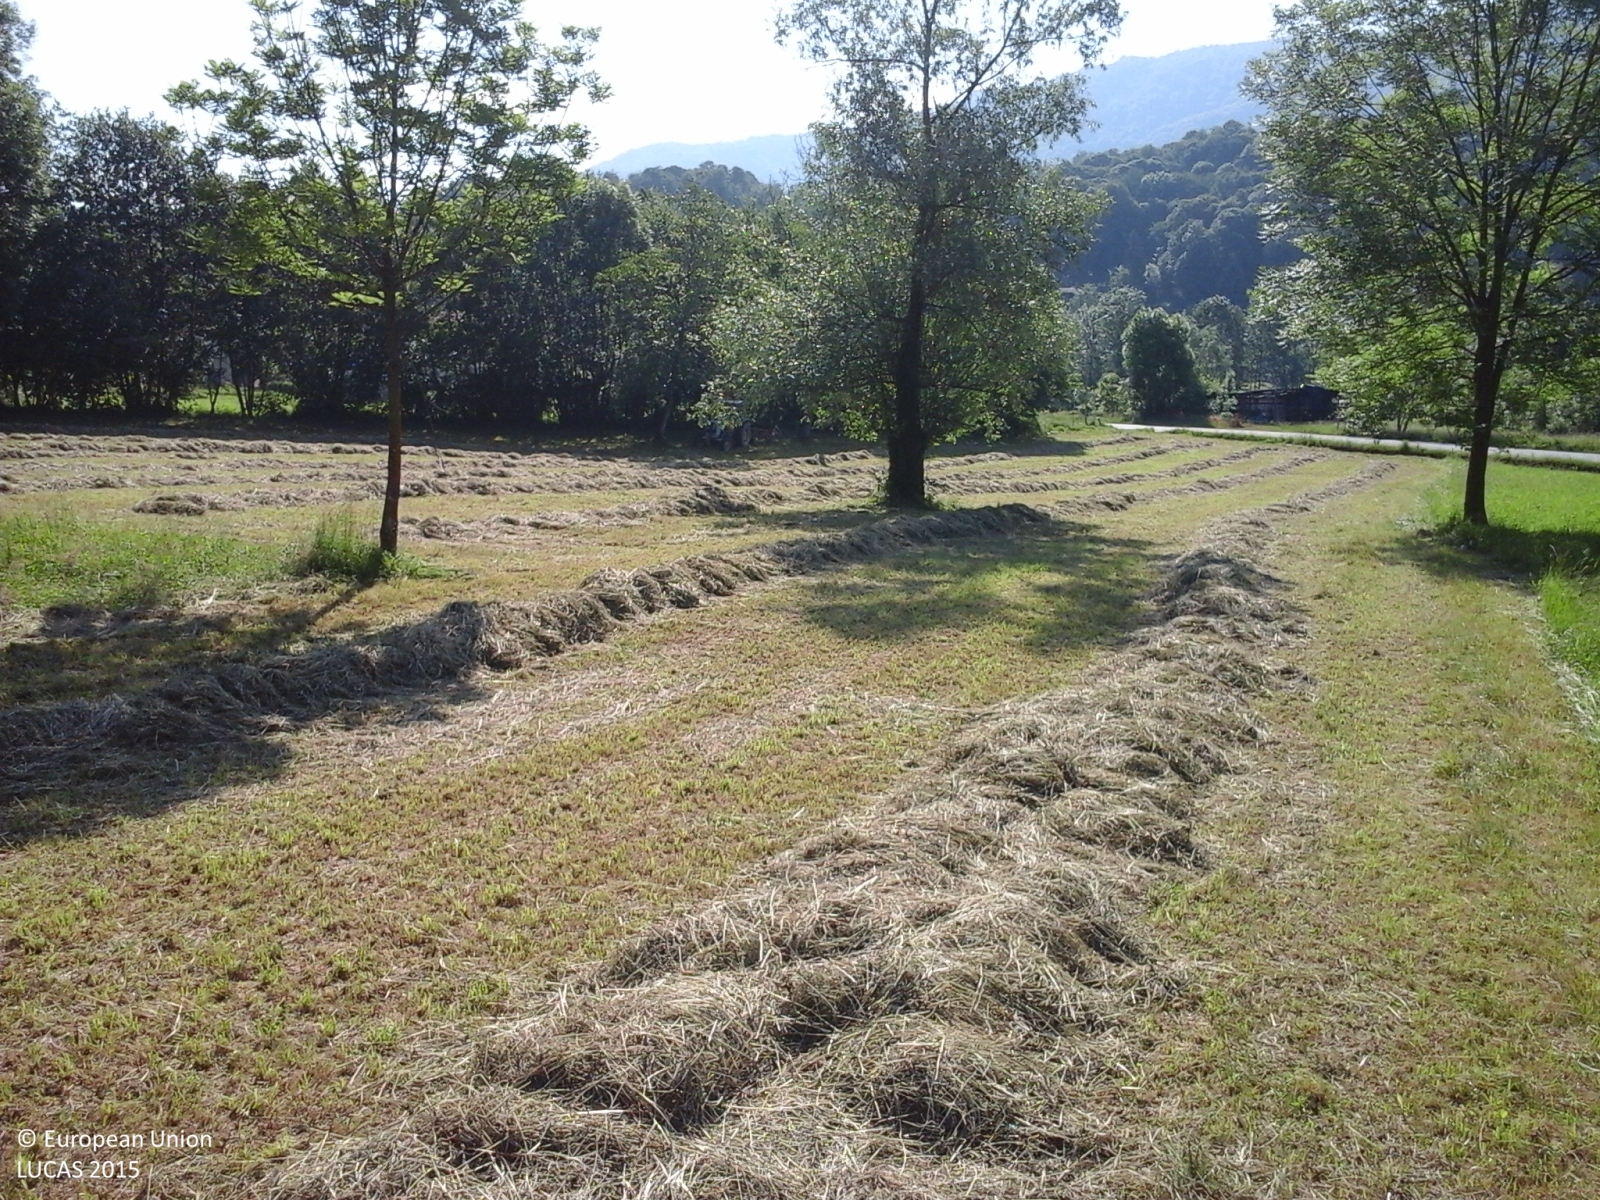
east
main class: Grassland
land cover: Grassland without tree/shrub cover
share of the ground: > 75 %
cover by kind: herbaceous plants 100 %
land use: Agriculture (excluding fallow land and kitchen gardens)
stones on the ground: 25 - 50 %
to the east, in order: Grassland without tree/shrub cover; Abandoned hedges; Grassland without tree/shrub cover; Abandoned hedges; Grassland without tree/shrub cover; Abandoned hedges; Ditches and canals; Grass margins; Paved roads, cycling and walking lanes; Grassland without tree/shrub cover; Artificial constructions in urban areas; Single bushes/trees; Tracks; Single bushes/trees; Paved roads, cycling and walking lanes; Grassland without tree/shrub cover; Tracks; Grassland without tree/shrub cover; Paved roads, cycling and walking lanes; Single bushes/trees; Grassland without tree/shrub cover; Electric lines; Grassland without tree/shrub cover; Abandoned hedges; Ditches and canals; Grassland without tree/shrub cover
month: May
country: IT
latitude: 44.6942
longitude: 7.2920
